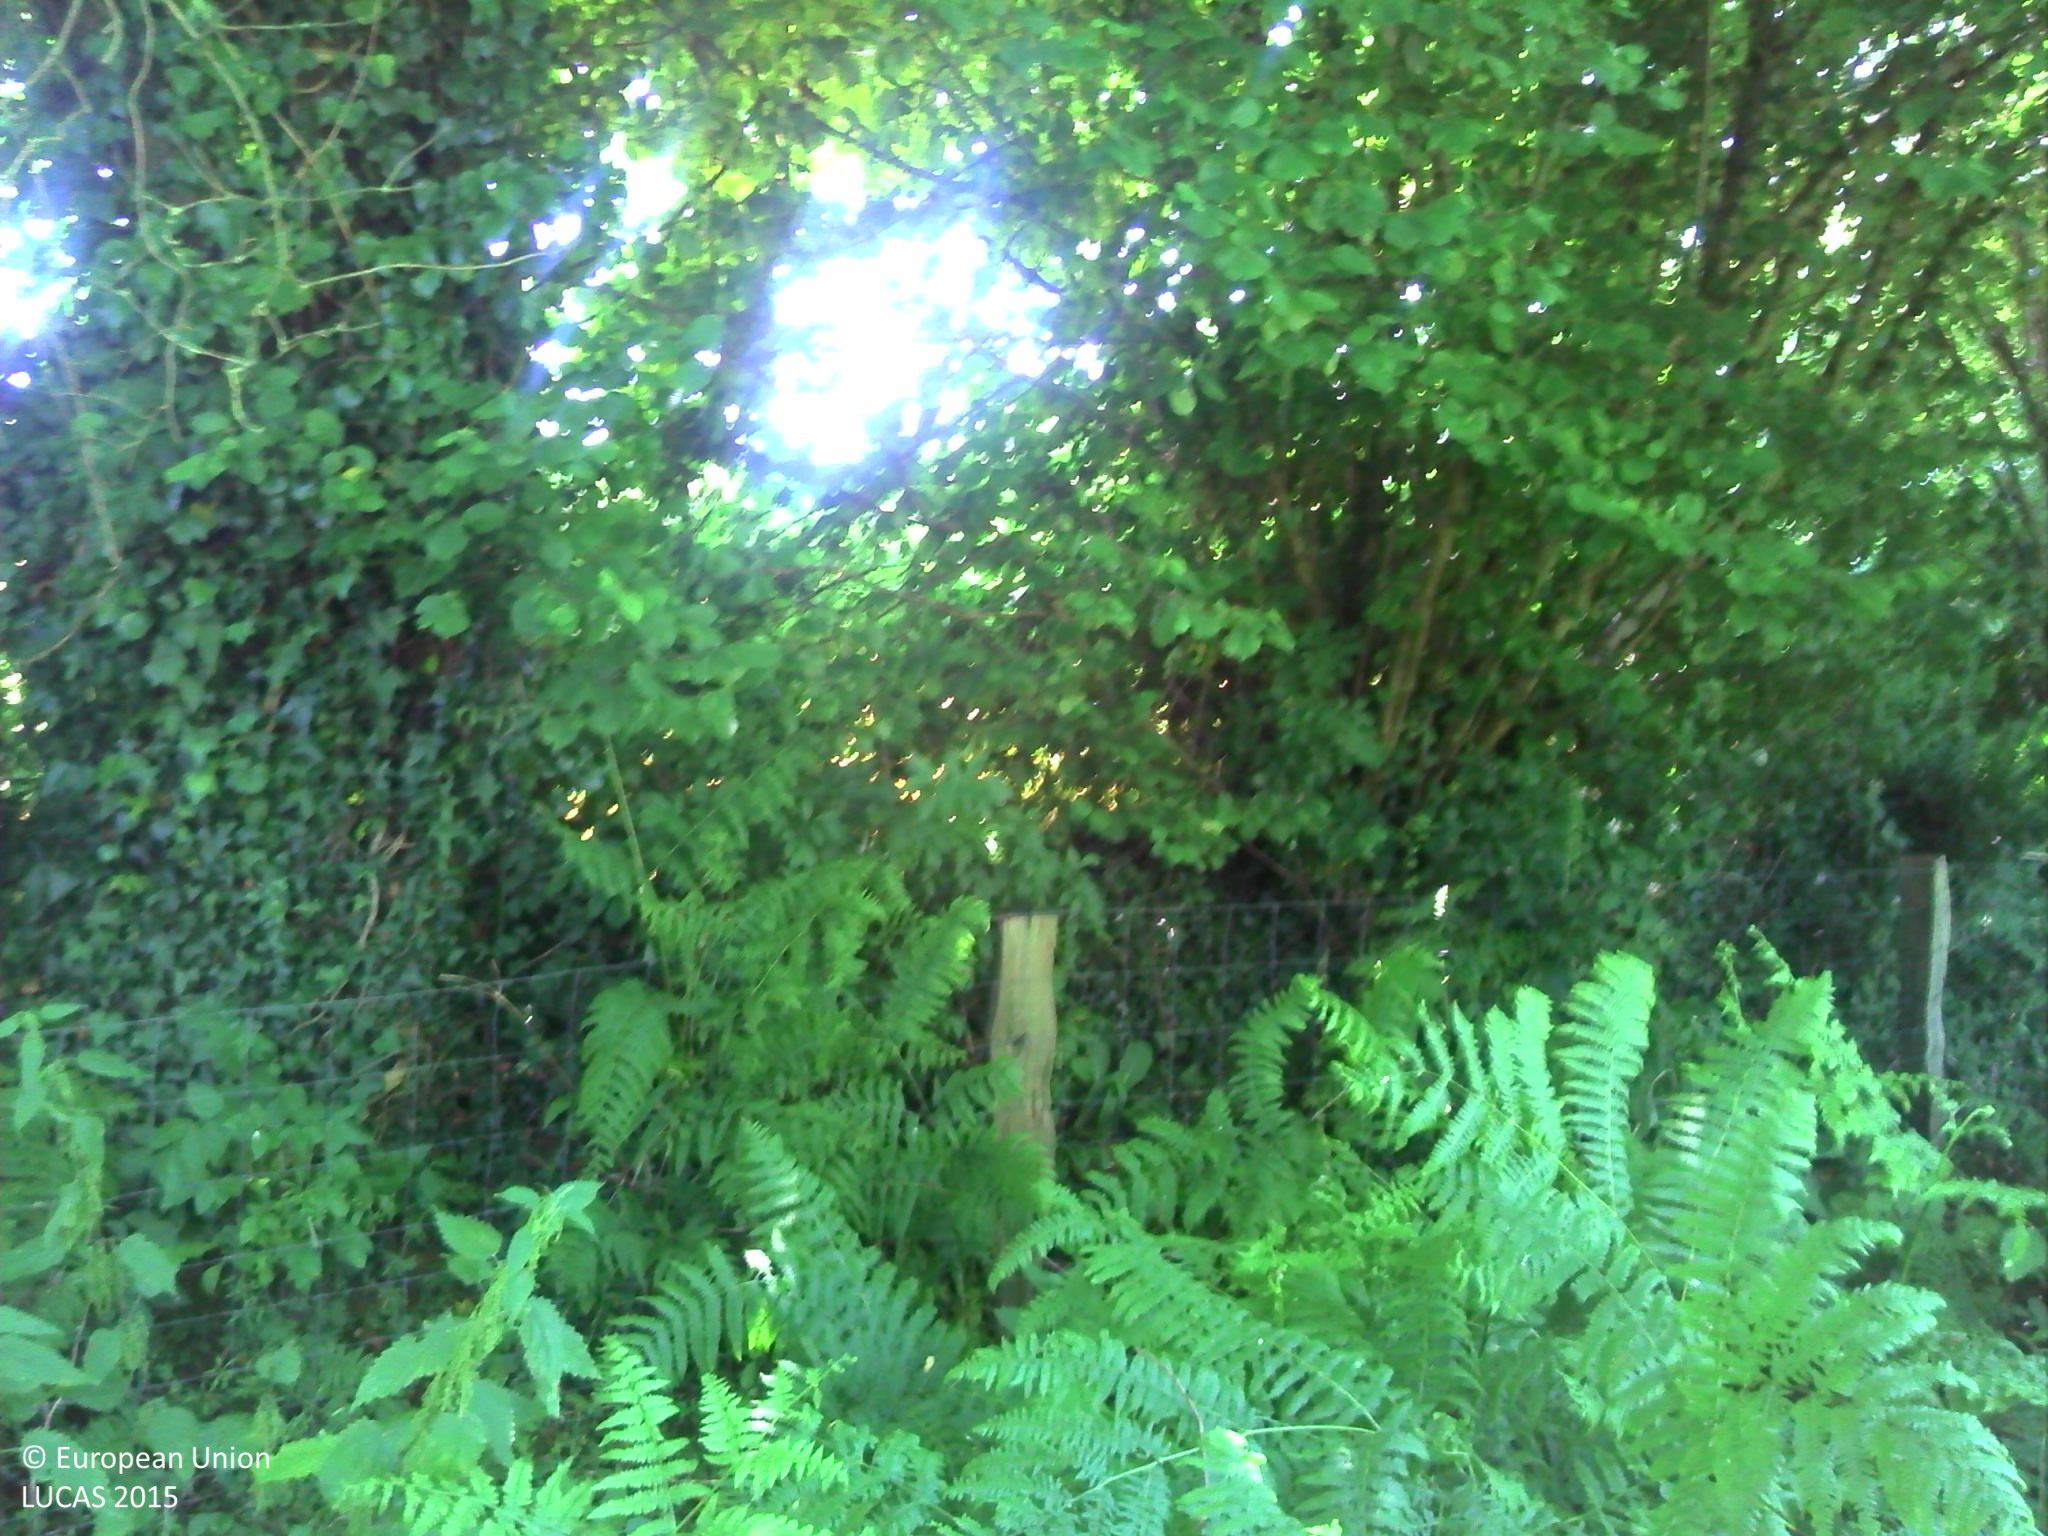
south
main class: Cropland
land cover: Nuts trees
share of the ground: > 75 %
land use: Agriculture (excluding fallow land and kitchen gardens)
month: July
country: FR
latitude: 49.0510
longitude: -1.3624
